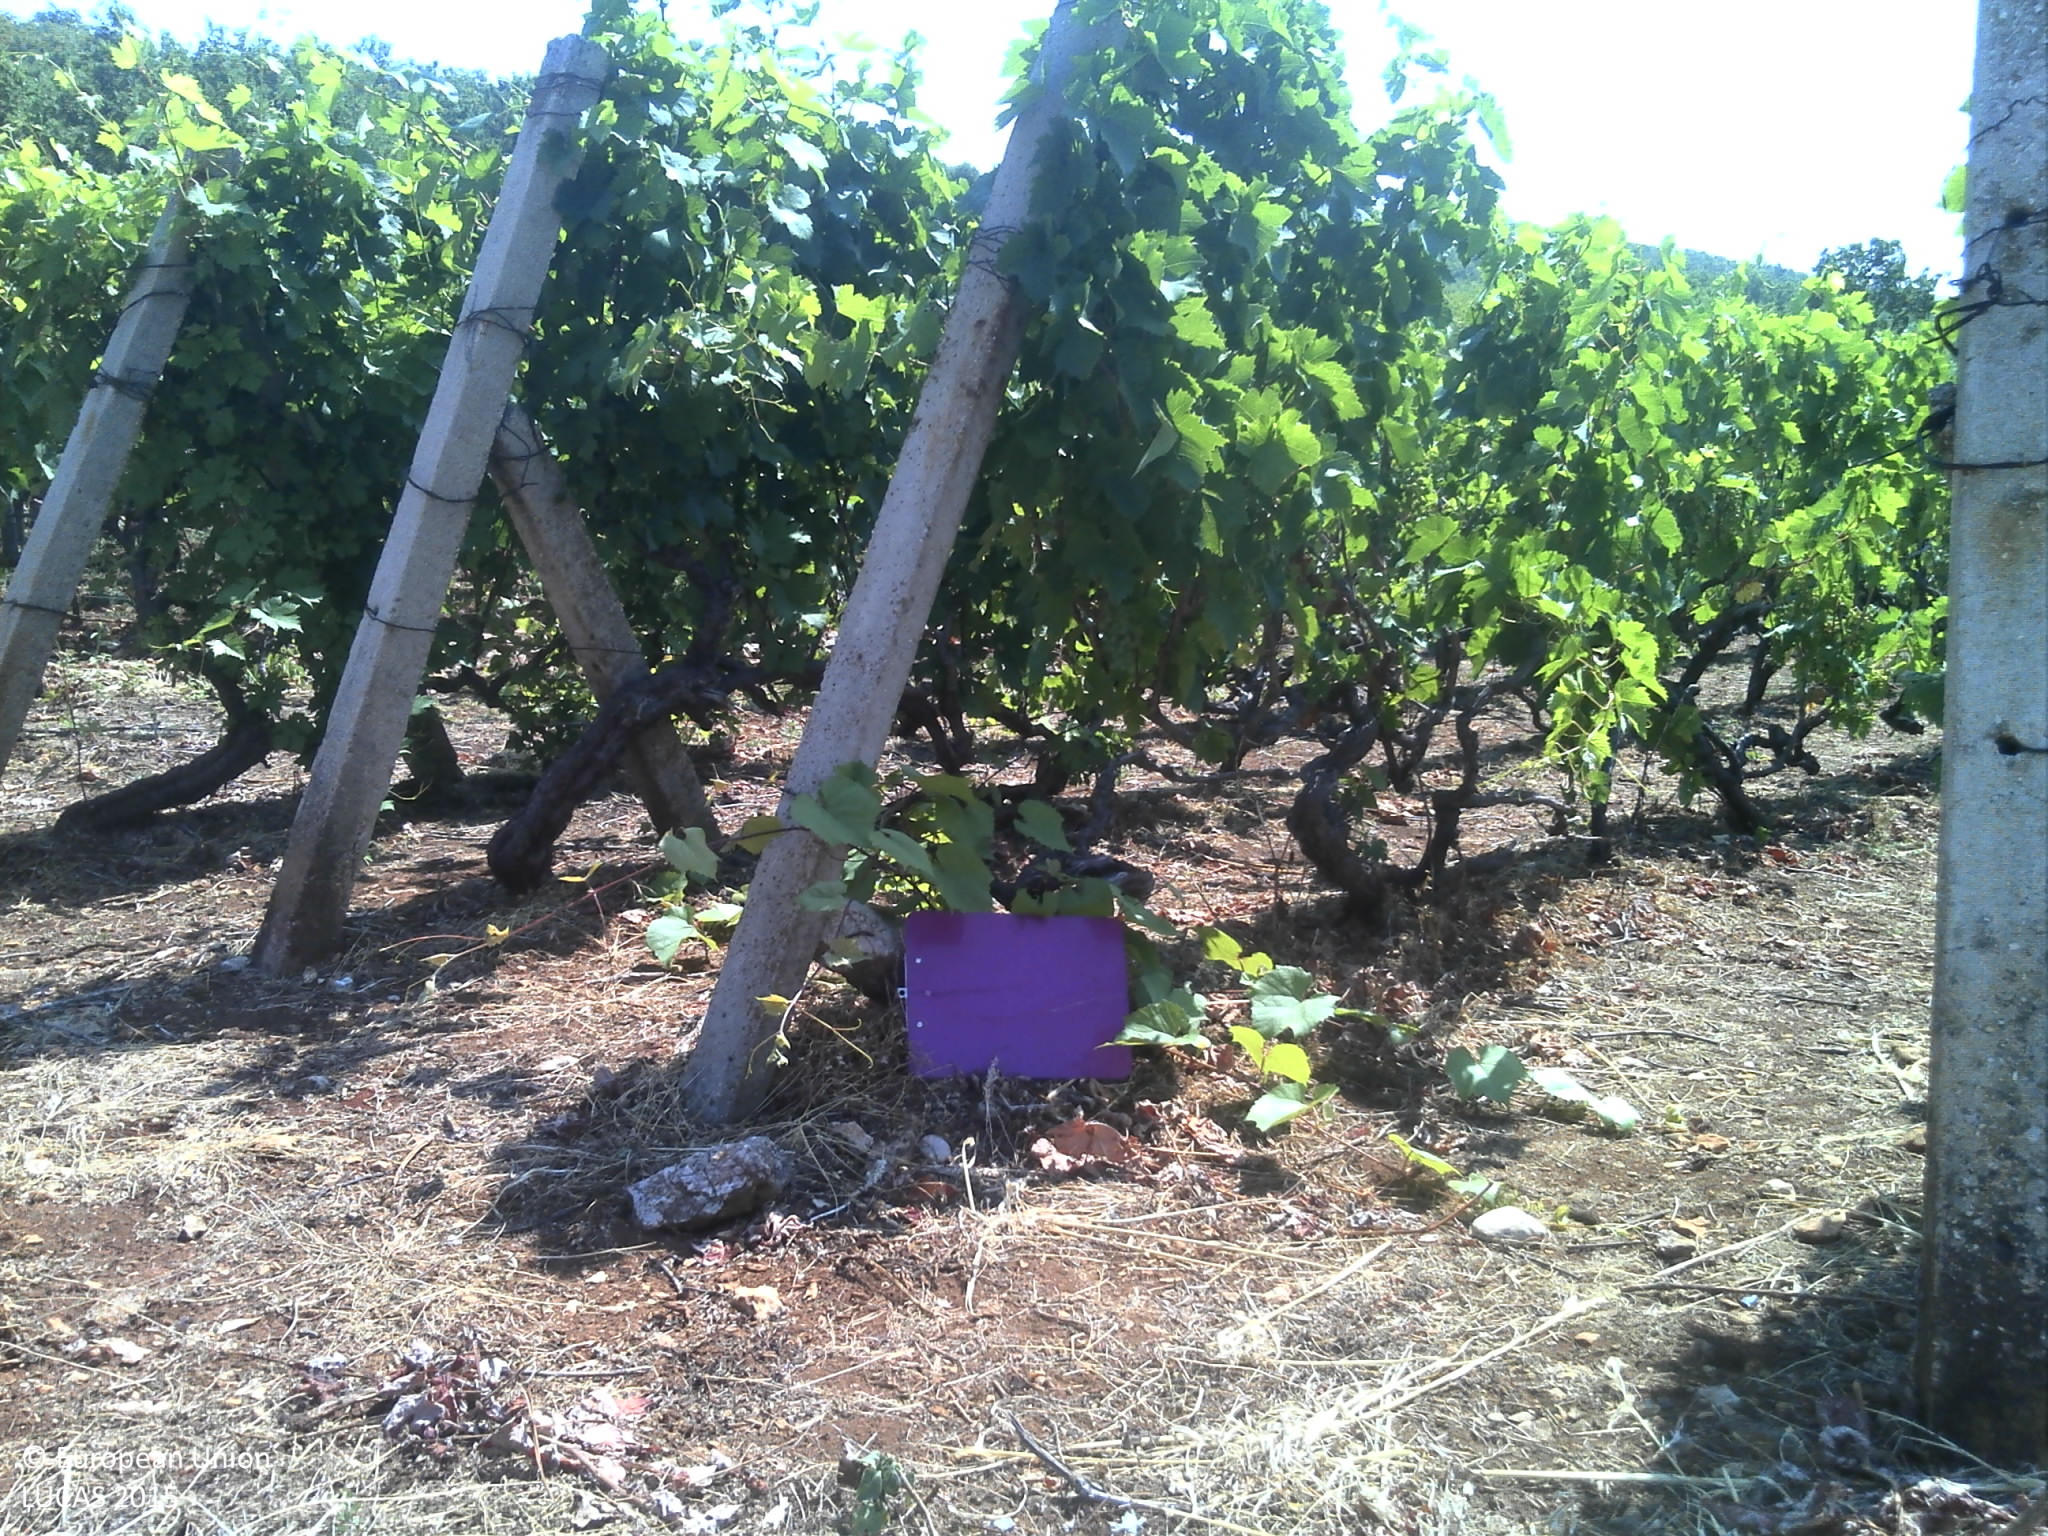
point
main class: Cropland
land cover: Vineyards
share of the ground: > 75 %
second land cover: Other bare soil
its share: > 75 %
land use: Agriculture (excluding fallow land and kitchen gardens)
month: July
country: HR
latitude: 43.4435
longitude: 17.2697
